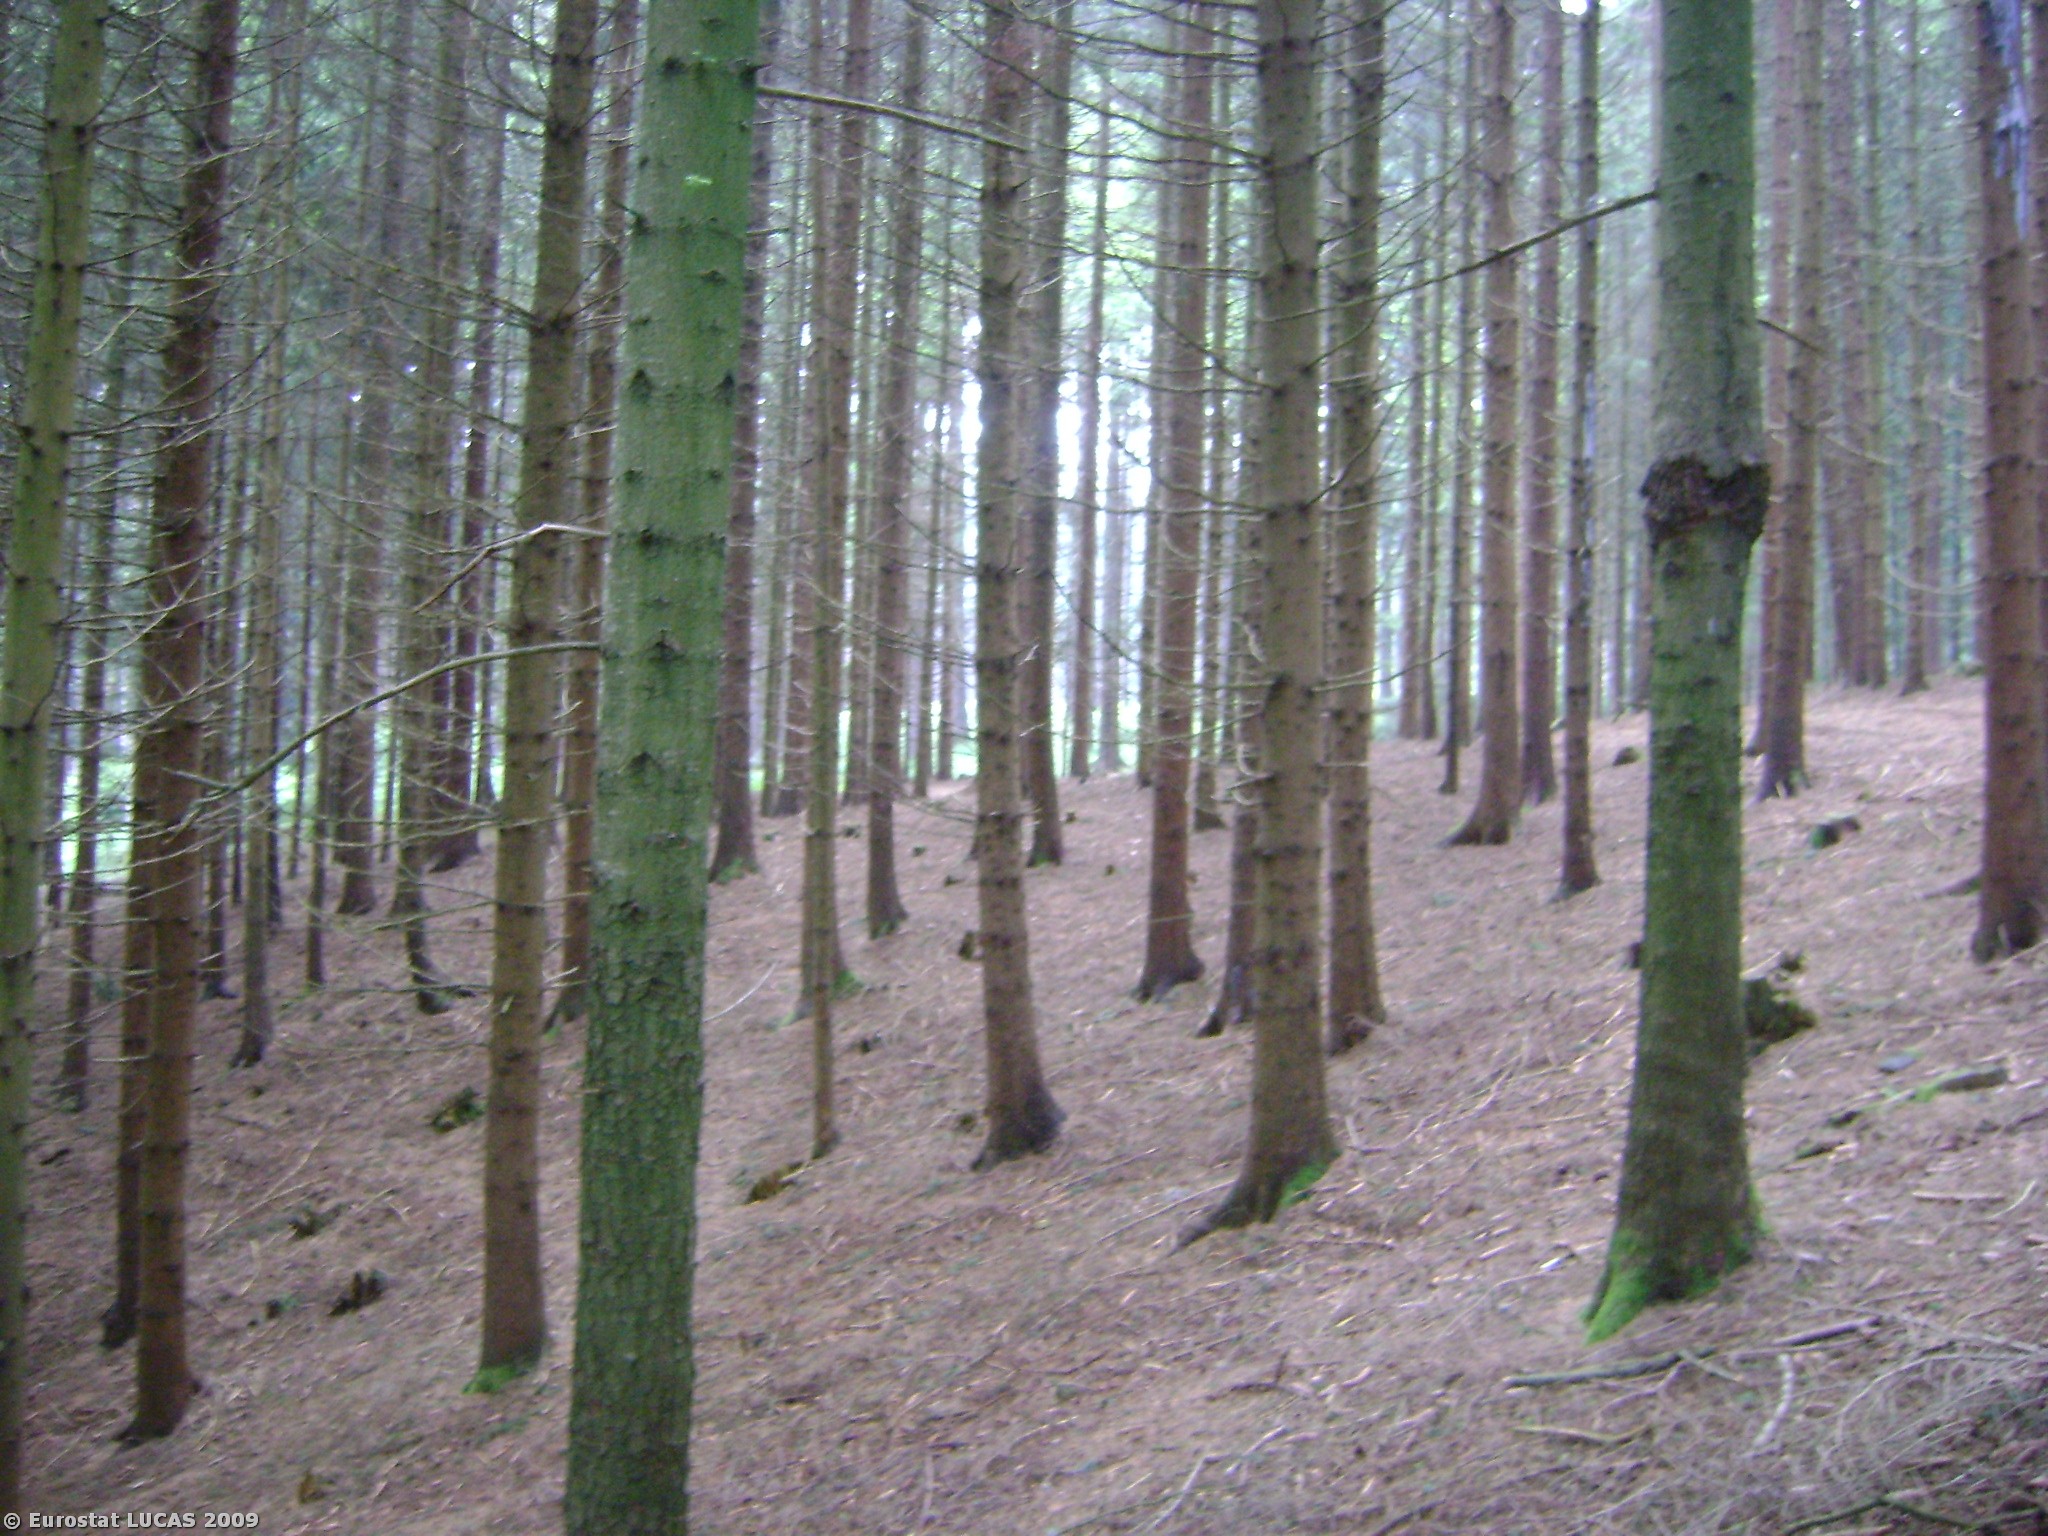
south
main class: Woodland
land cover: Coniferous woodland
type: hemiboreal forest and nemoral coniferous forest and mixed broadleaved-coniferous forest
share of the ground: > 75 %
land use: Forestry
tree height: > 5 m
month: May
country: AT
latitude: 47.9602
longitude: 13.2264
